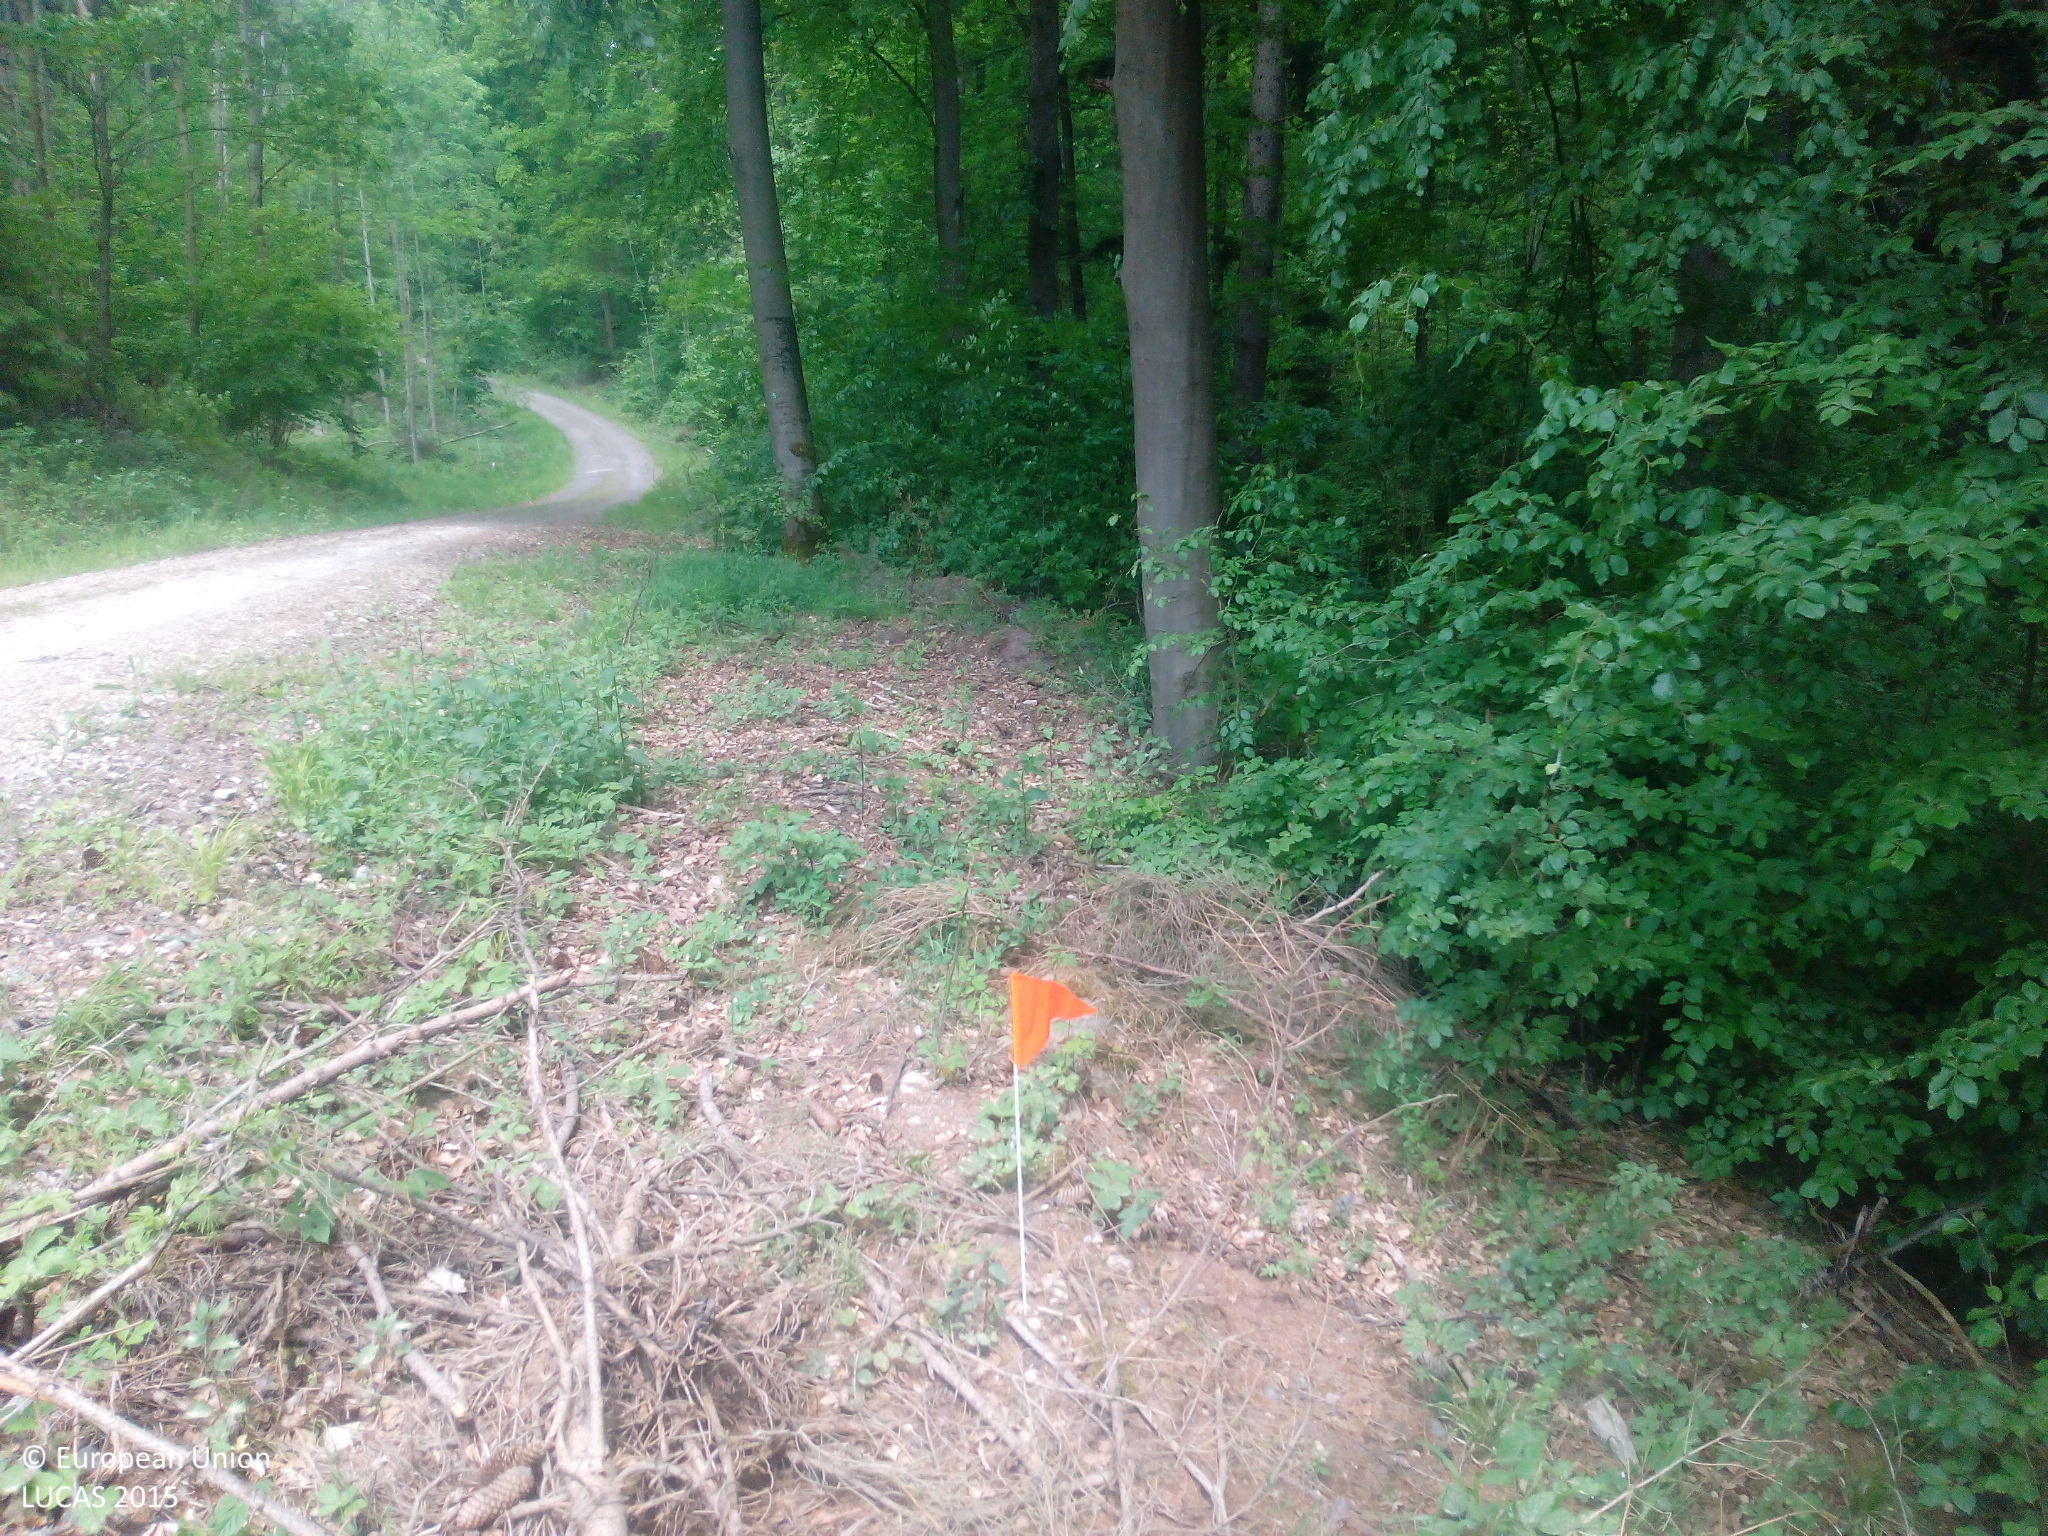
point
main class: Woodland
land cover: Spruce dominated mixed woodland
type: hemiboreal forest and nemoral coniferous forest and mixed broadleaved-coniferous forest
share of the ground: > 75 %
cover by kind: broadleaved forest trees 70 %, coniferous forest trees 30 %
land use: Forestry
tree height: > 5 m
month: May
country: DE
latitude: 50.2163
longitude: 10.9387
